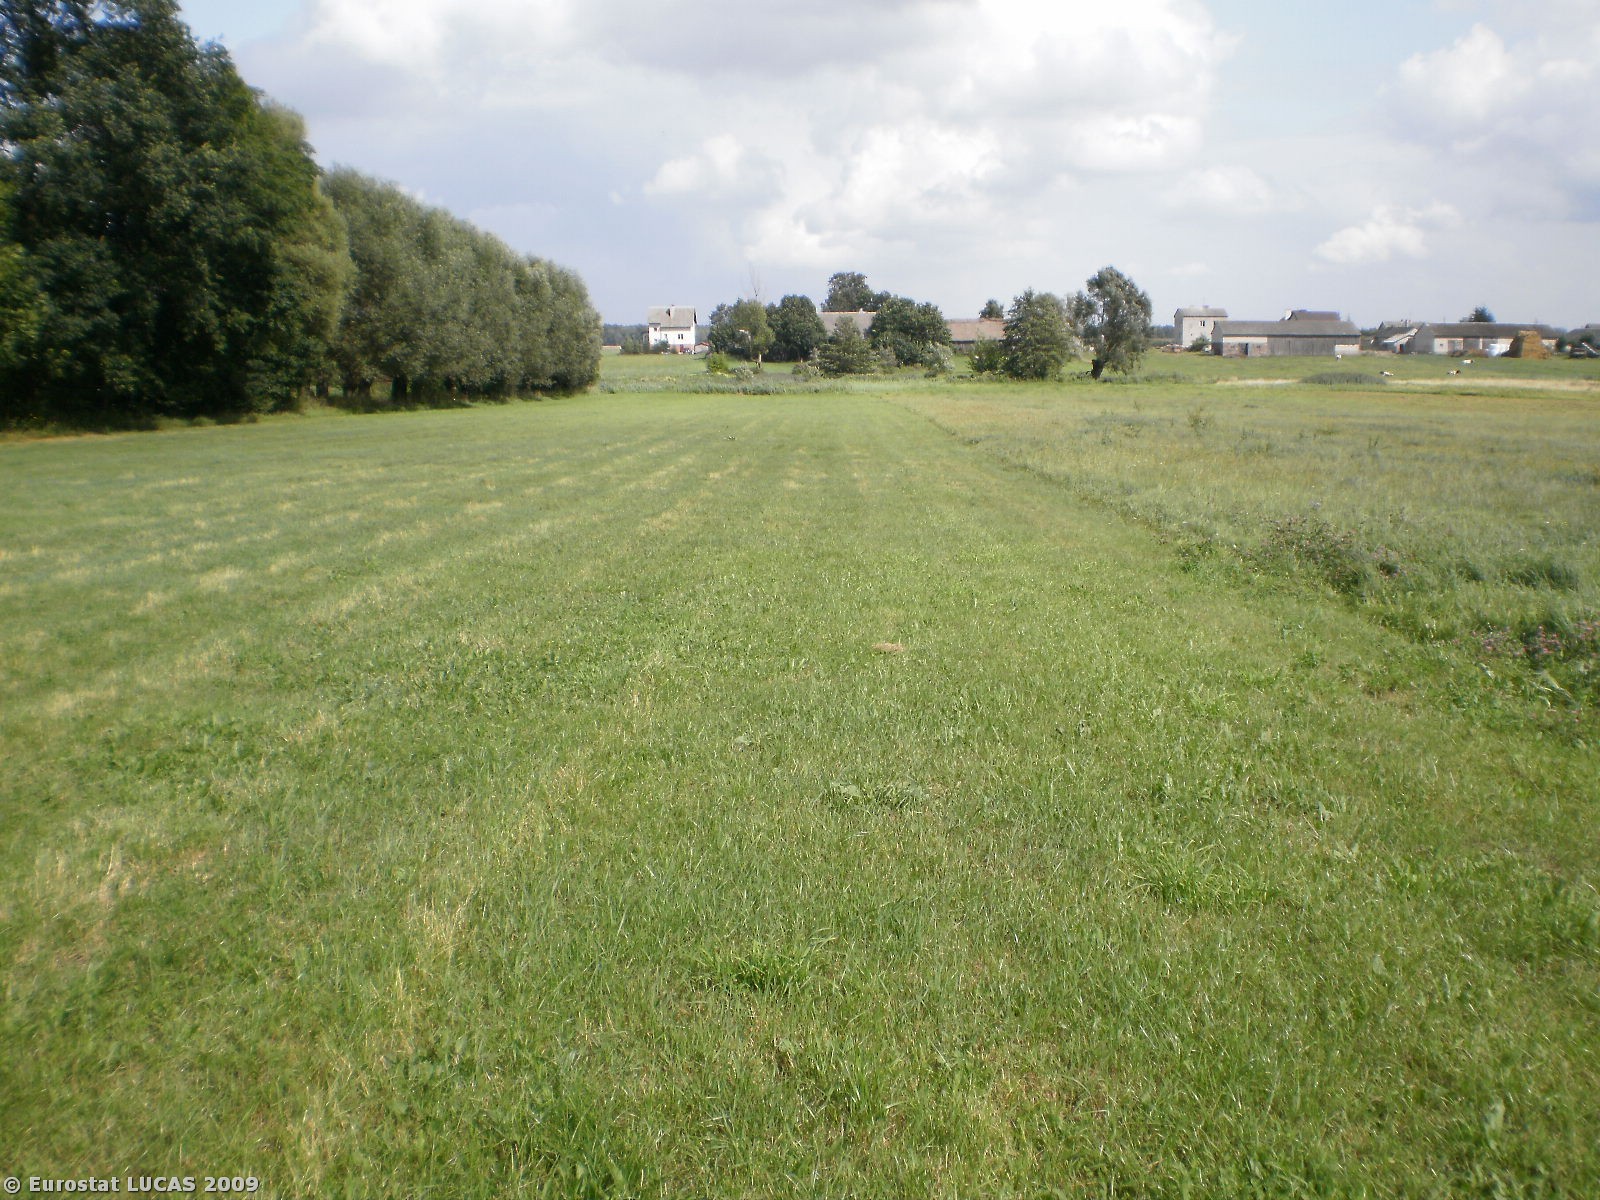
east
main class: Grassland
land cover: Grassland without tree/shrub cover
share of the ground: > 75 %
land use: Agriculture (excluding fallow land and kitchen gardens)
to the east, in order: Grassland without tree/shrub cover; Ditches and canals; Grassland with sparse tree/shrub cover; Grassland without tree/shrub cover
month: August
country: PL
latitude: 52.8282
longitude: 20.9821
